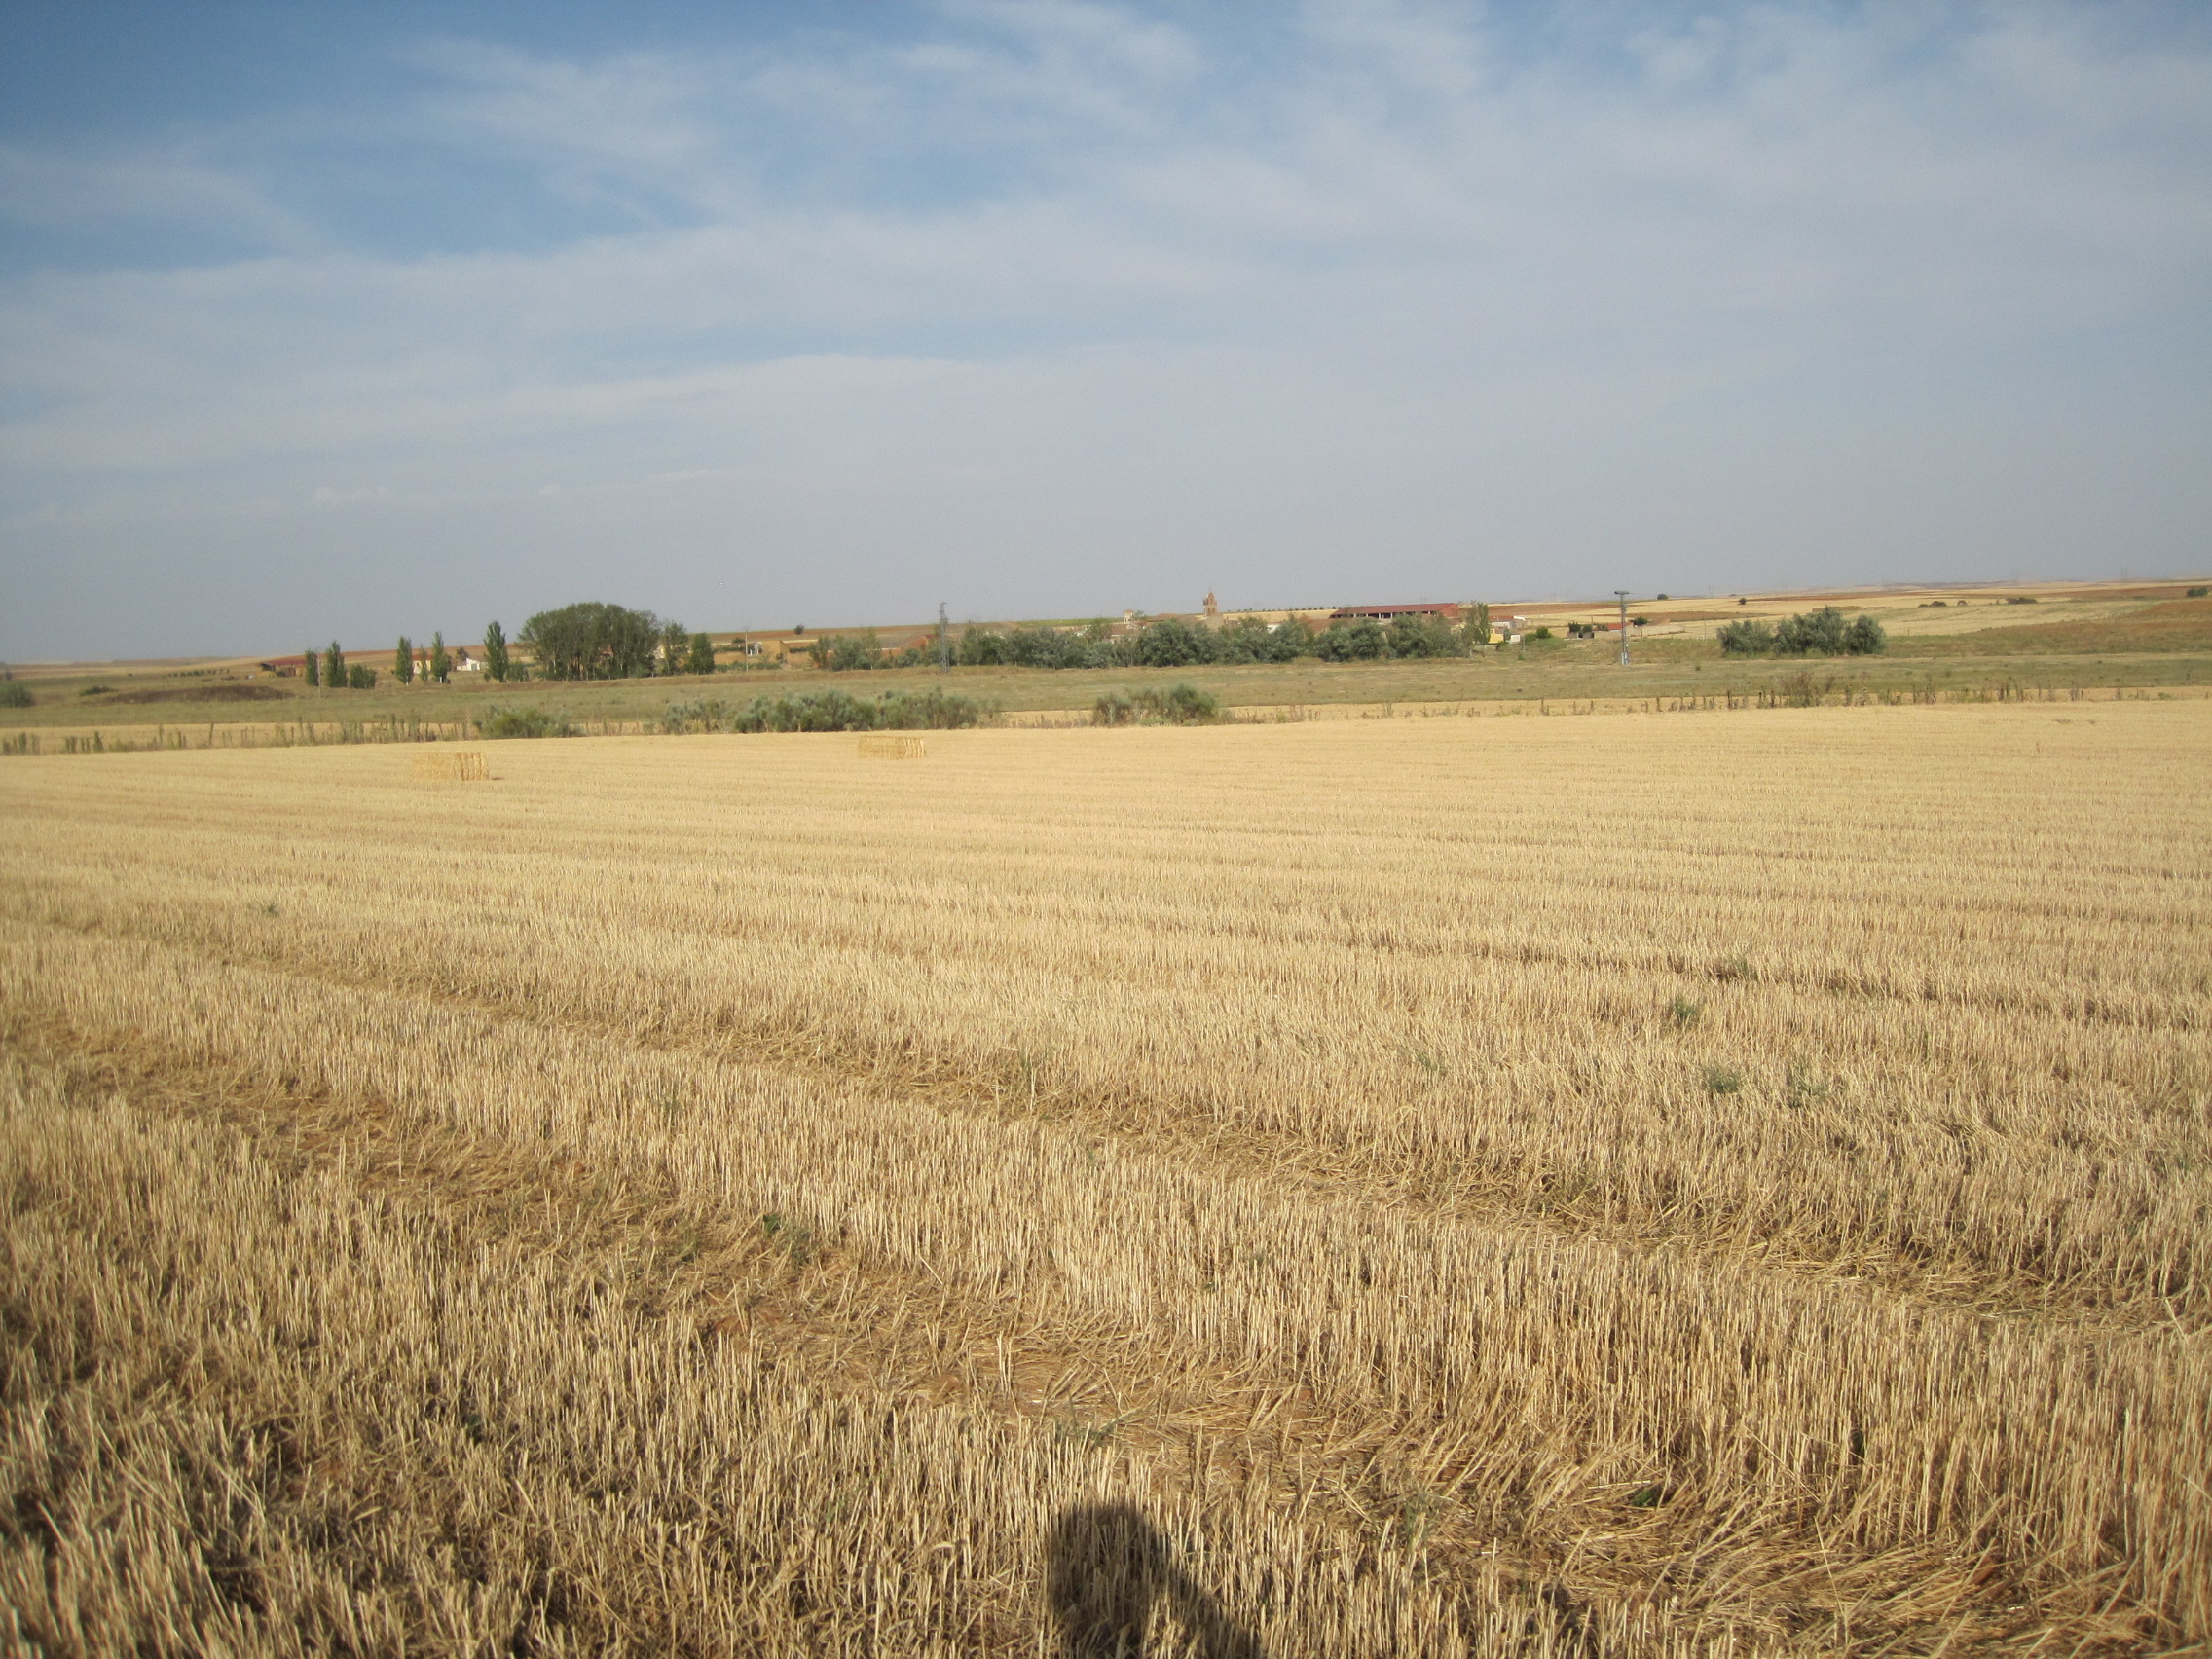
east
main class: Cropland
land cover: Common wheat
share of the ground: < 10 %
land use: Agriculture (excluding fallow land and kitchen gardens)
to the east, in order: Common wheat; Tracks; Grassland with sparse tree/shrub cover; Common wheat
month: July
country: ES
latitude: 41.7015
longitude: -5.5508
